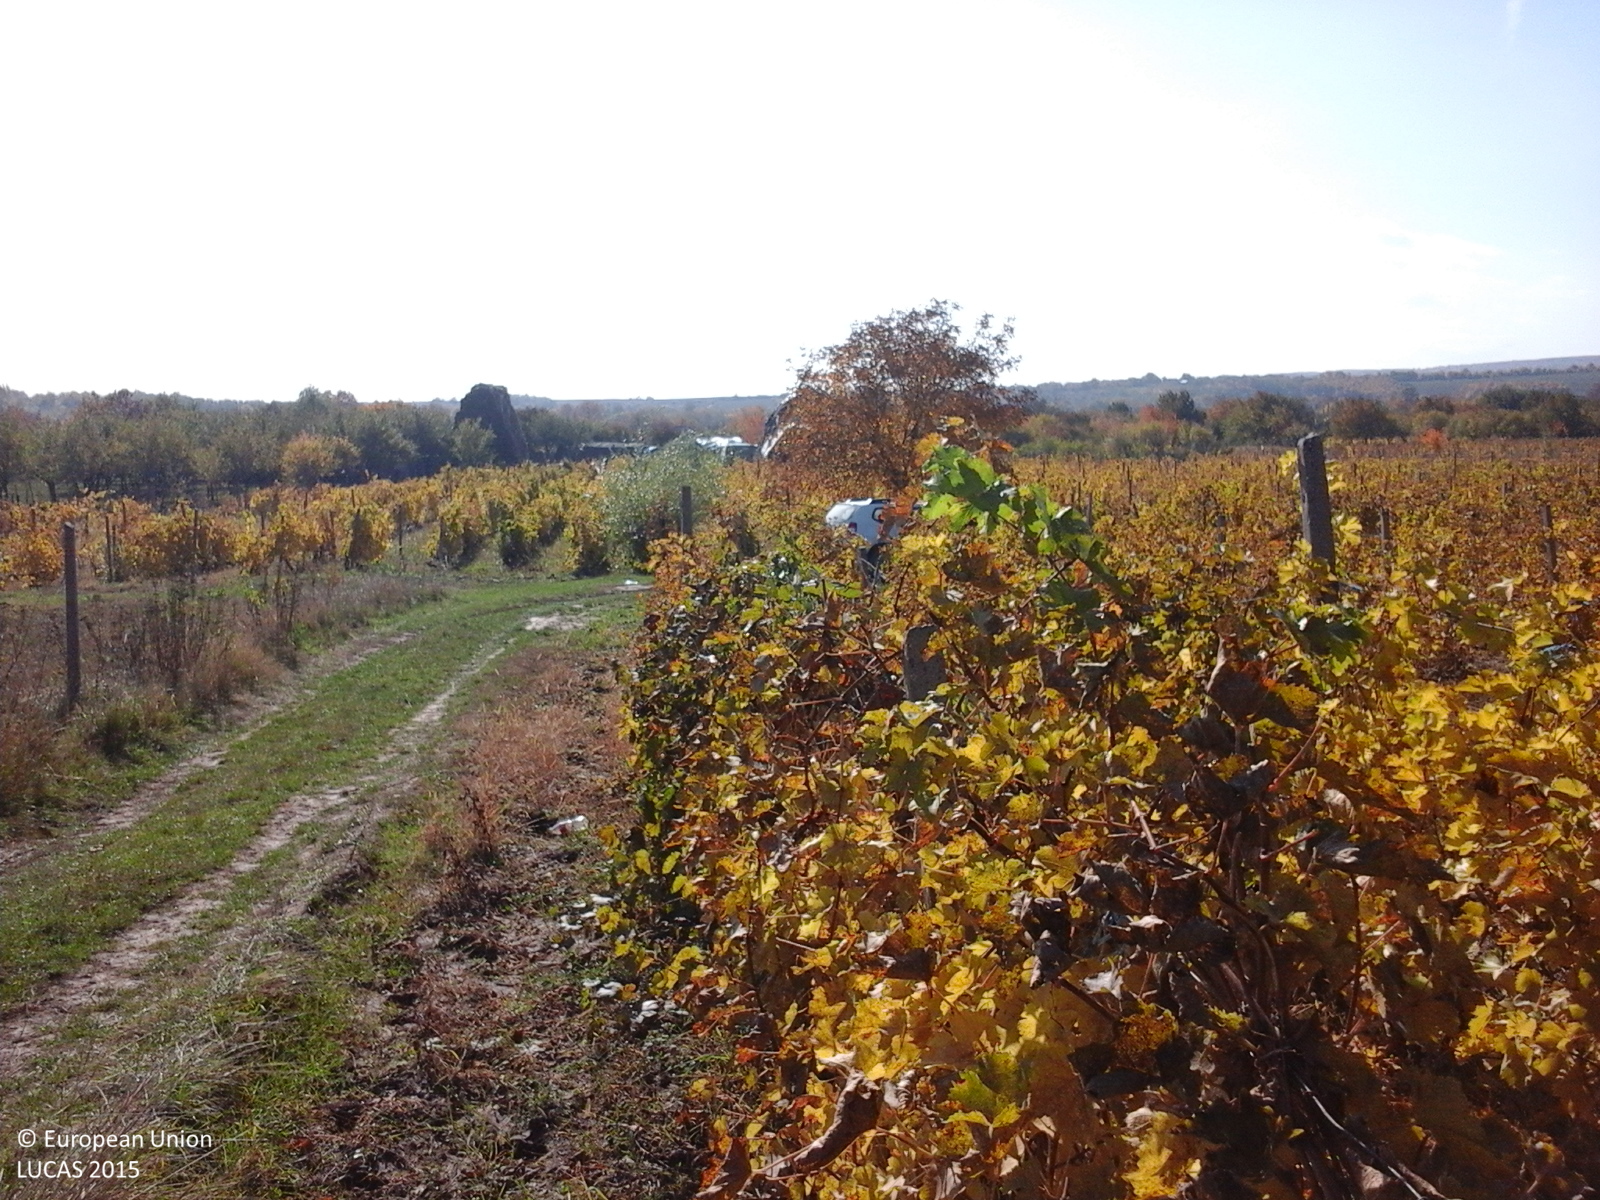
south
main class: Cropland
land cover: Vineyards
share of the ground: 50 - 75 %
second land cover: Other bare soil
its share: > 75 %
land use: Agriculture (excluding fallow land and kitchen gardens)
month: October
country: RO
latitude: 45.6296
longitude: 27.0610
